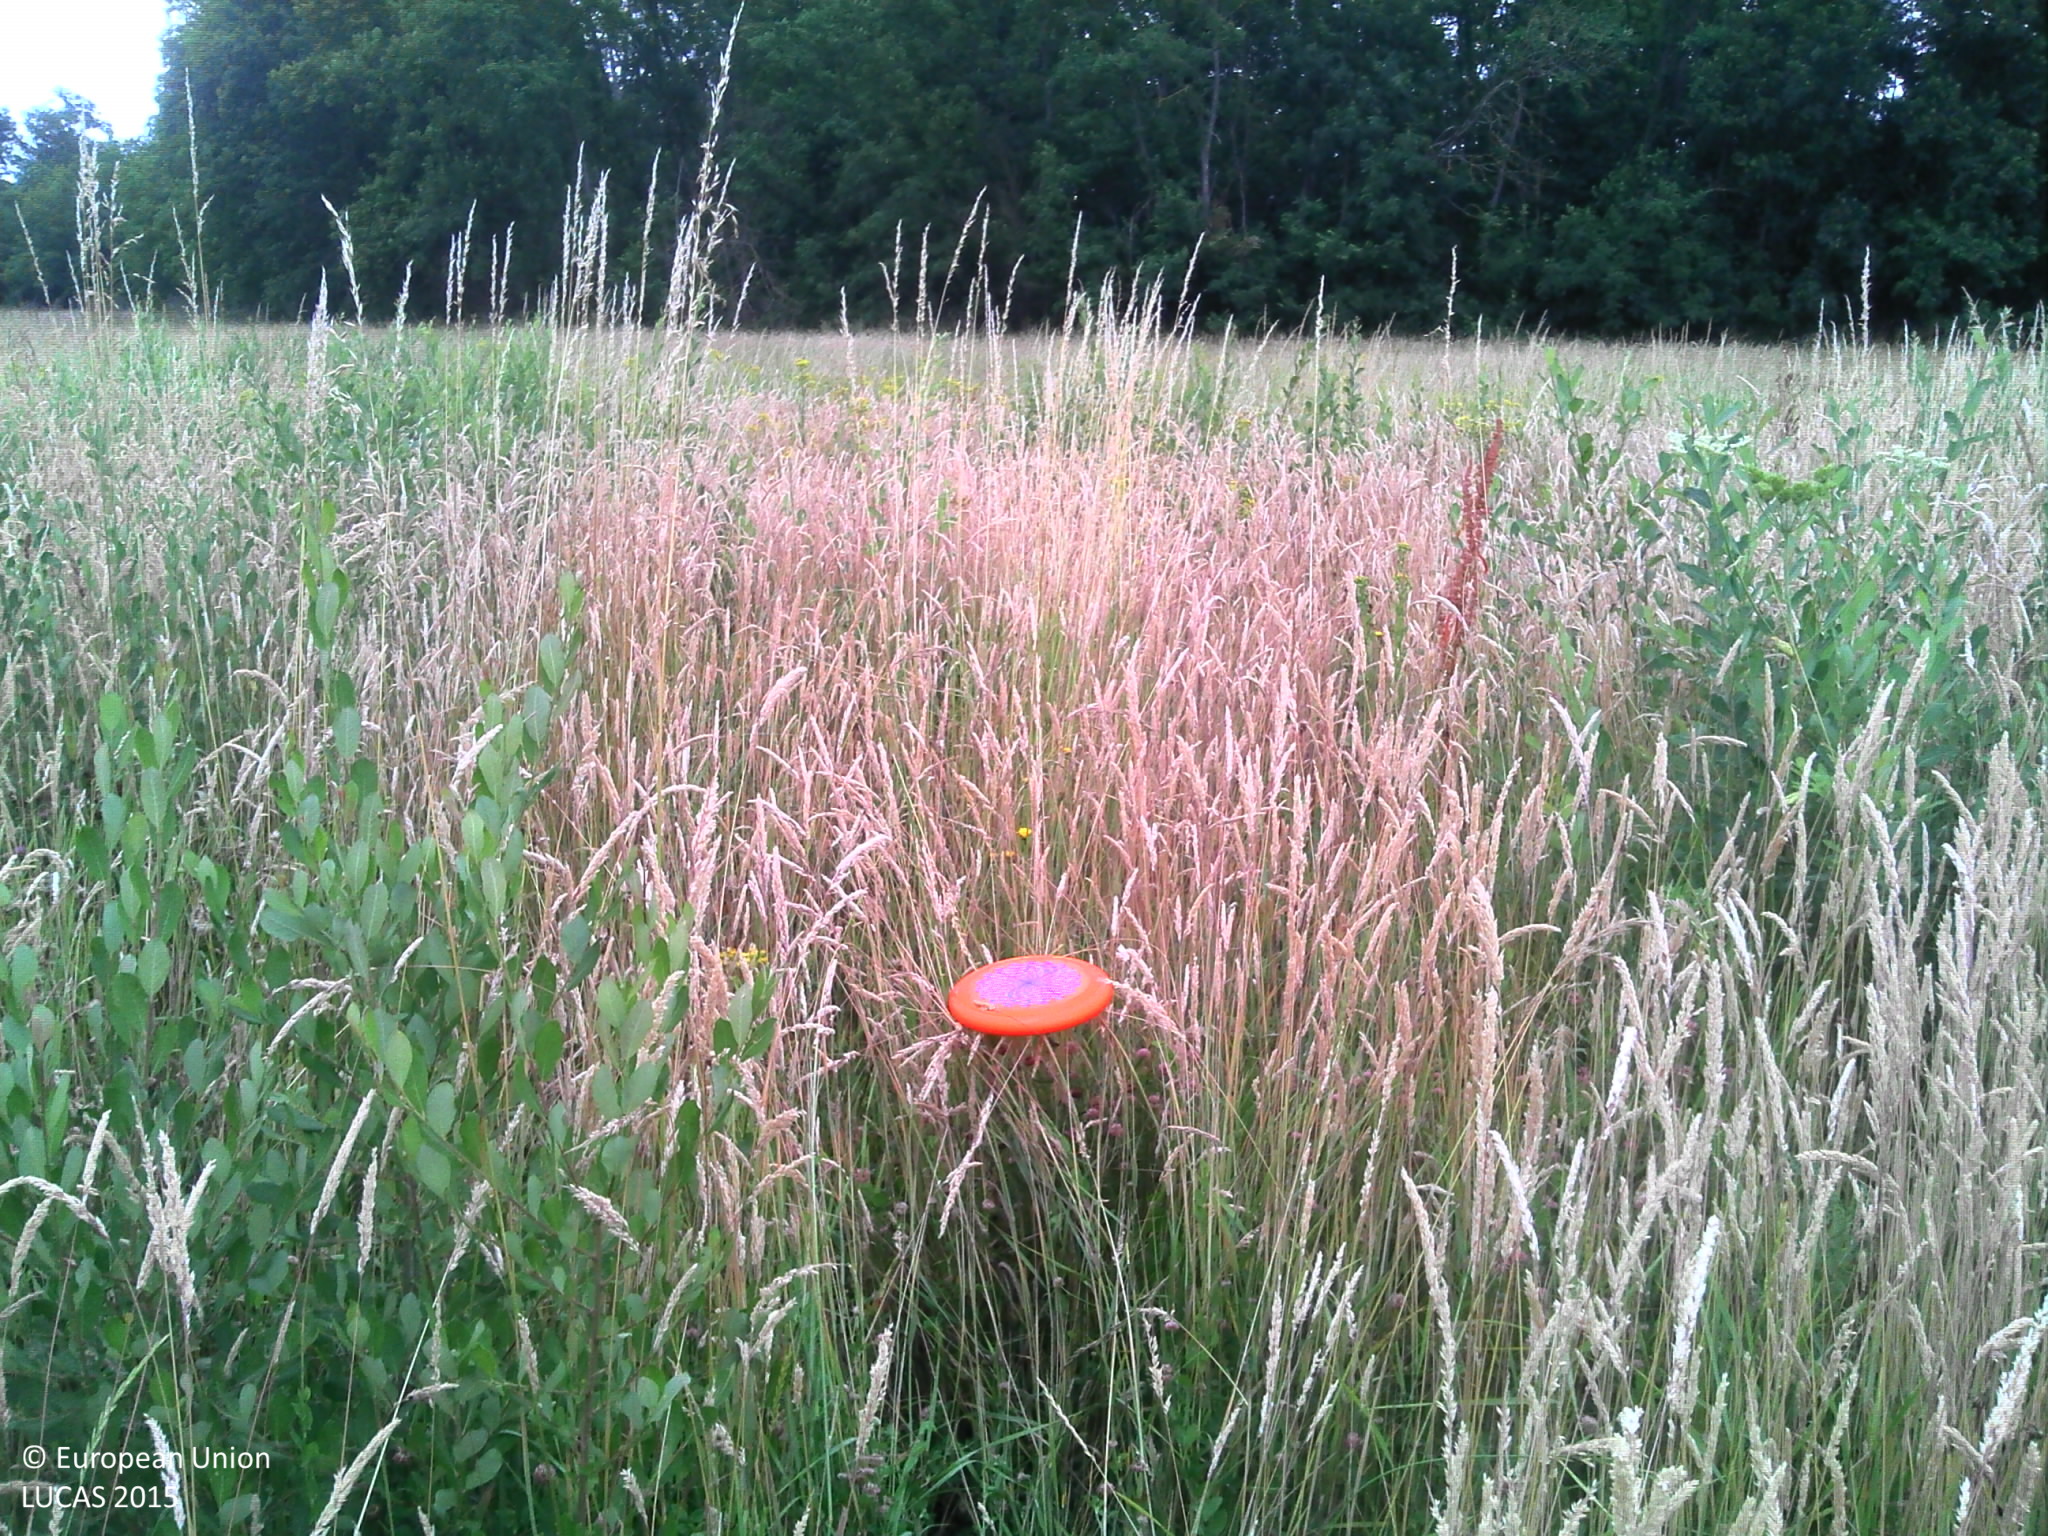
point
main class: Grassland
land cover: Grassland without tree/shrub cover
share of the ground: > 75 %
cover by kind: herbaceous plants 100 %
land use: Agriculture (excluding fallow land and kitchen gardens)
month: June
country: FR
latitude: 47.8356
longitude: 3.5425
